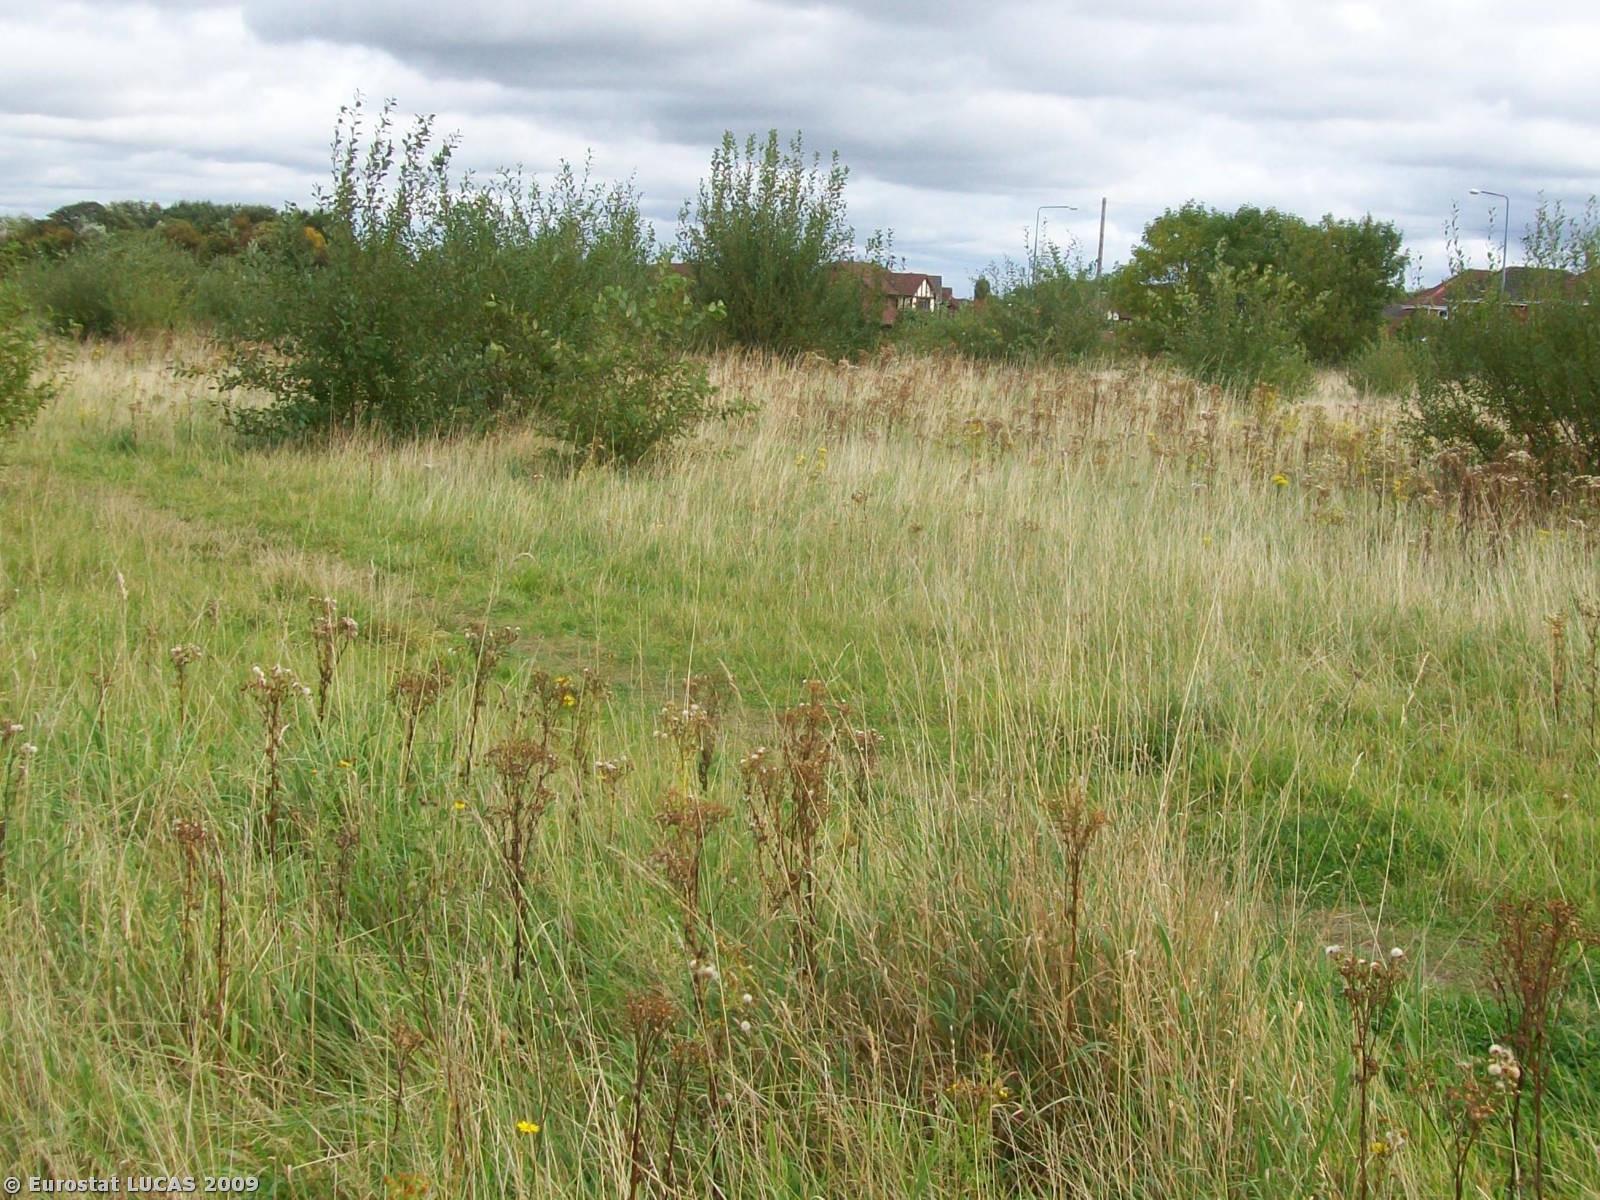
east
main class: Grassland
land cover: Grassland with sparse tree/shrub cover
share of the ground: 10 - 25 %
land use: Unused
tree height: > 5 m
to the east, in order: Grassland with sparse tree/shrub cover; Artificial constructions in urban areas
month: September
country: GB
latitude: 53.3714
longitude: -2.8318
